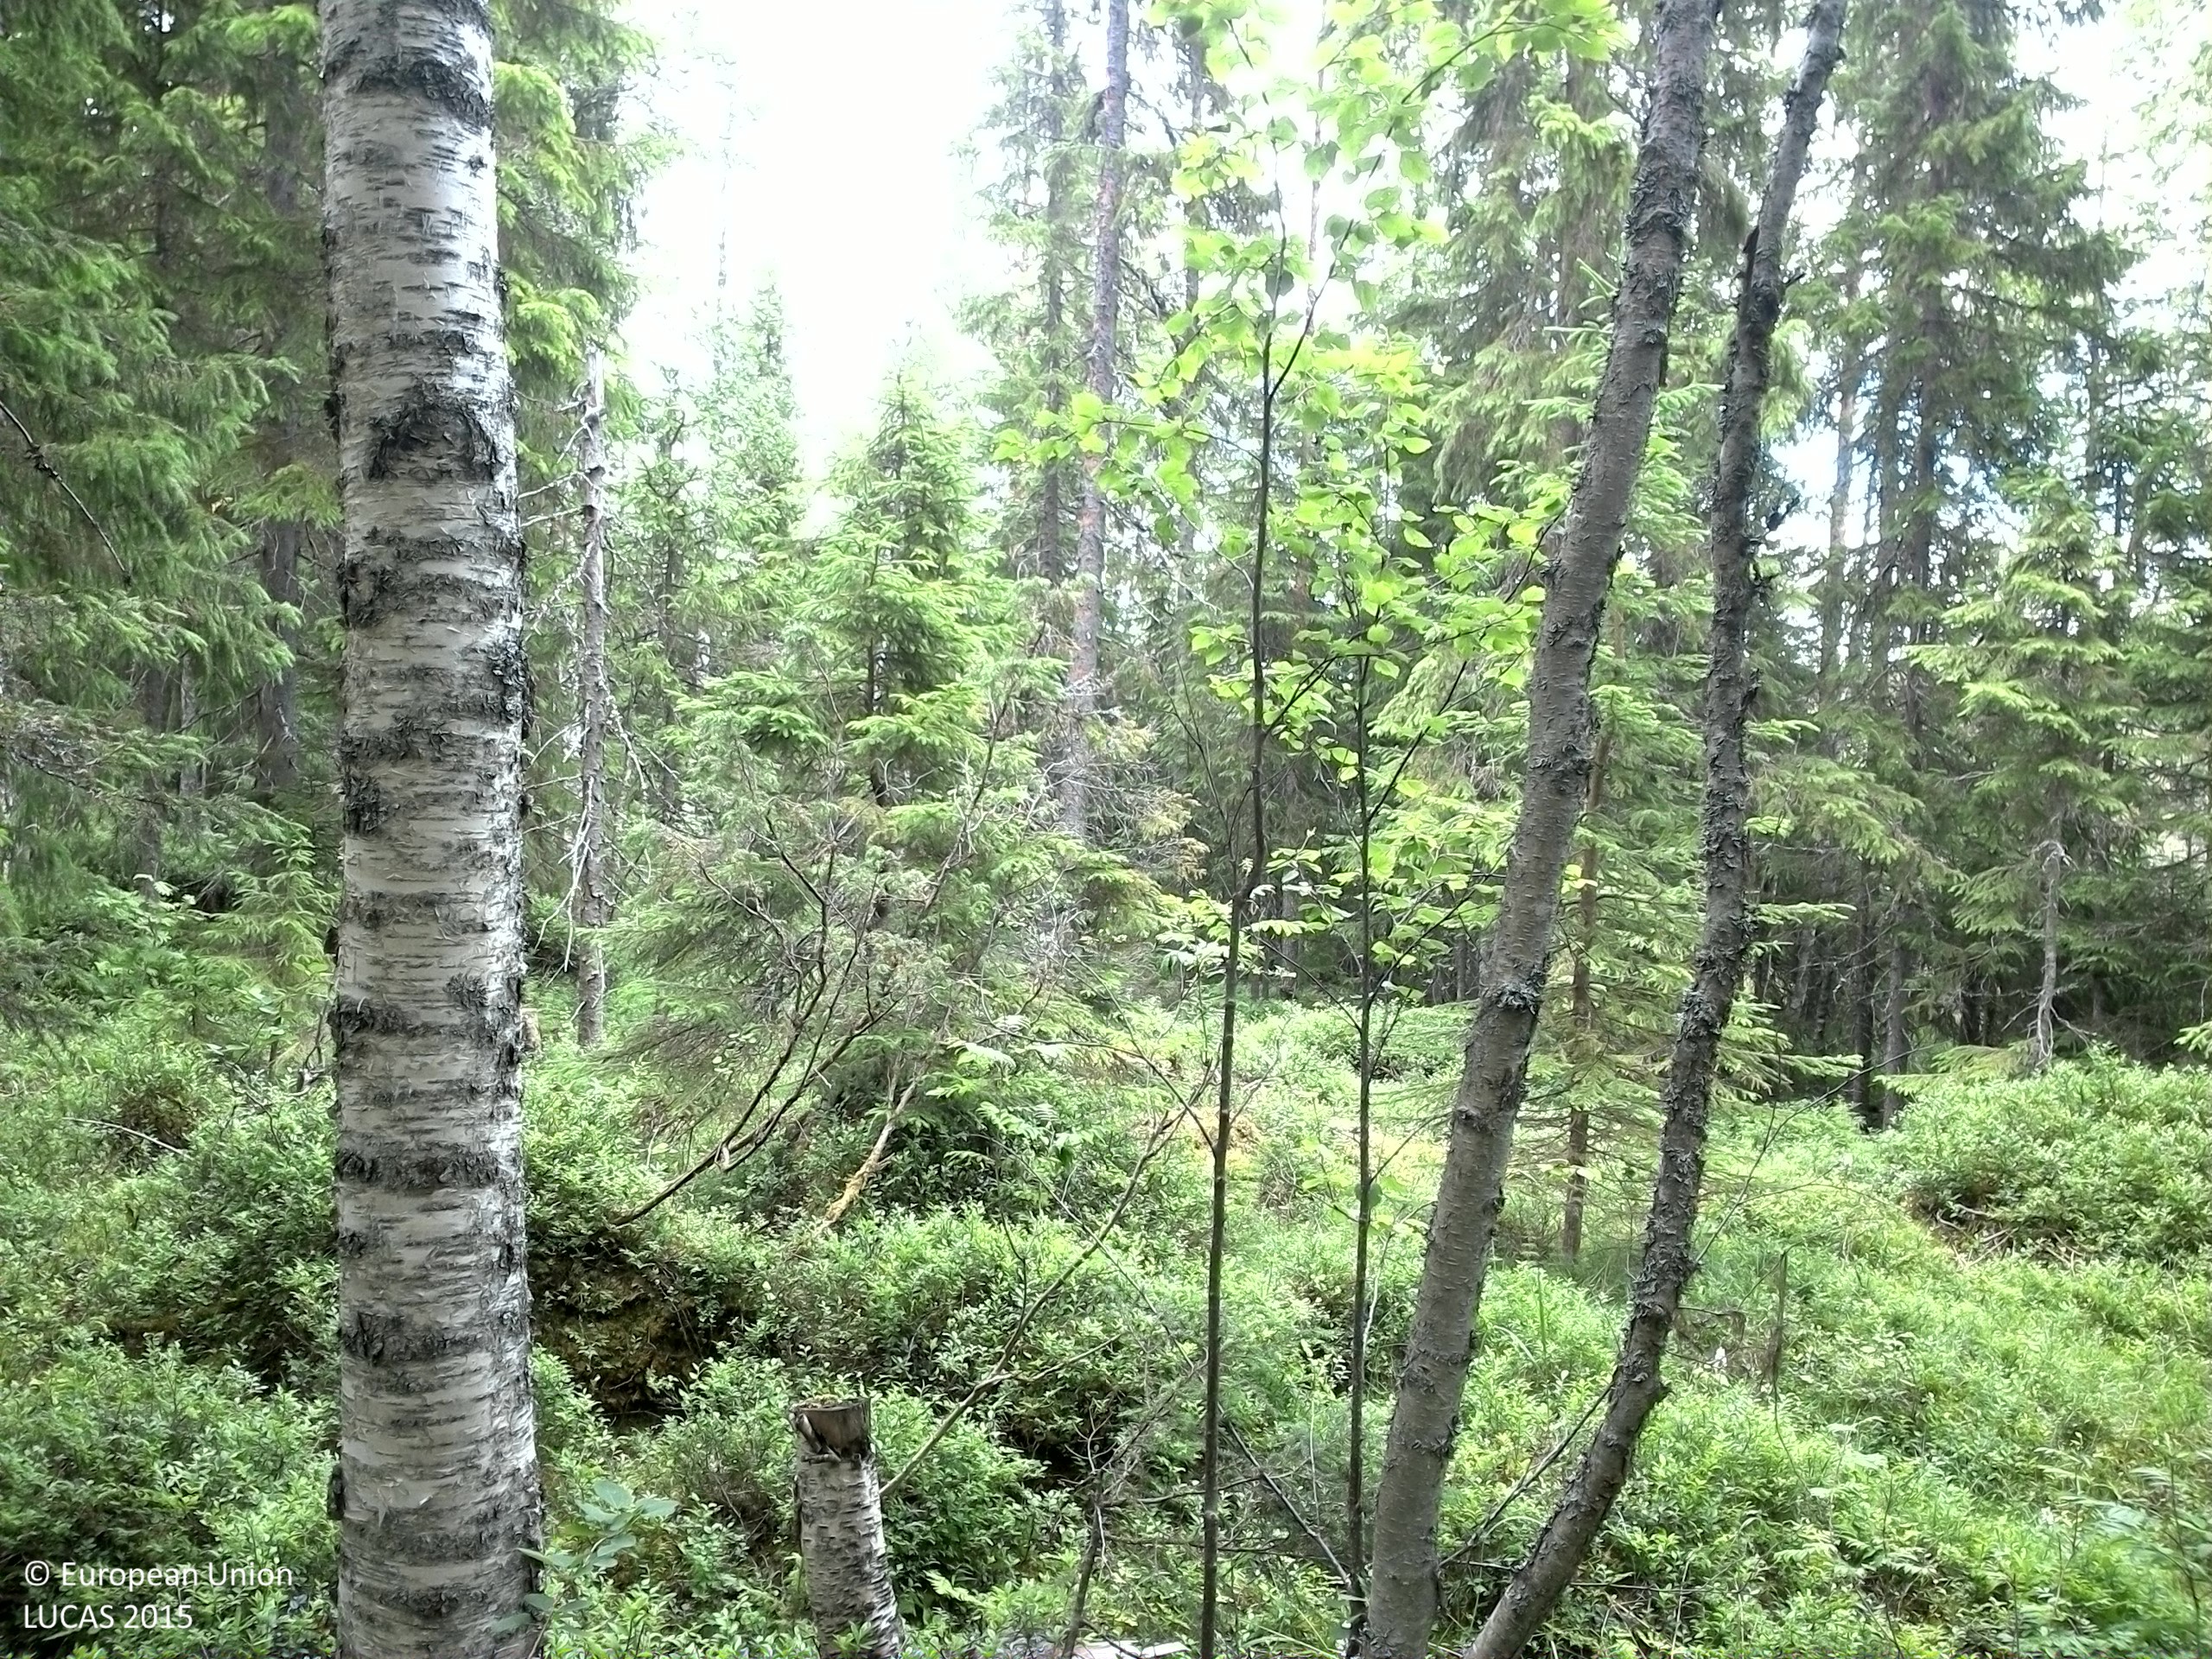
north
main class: Woodland
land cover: Spruce dominated mixed woodland
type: boreal forest
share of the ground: > 75 %
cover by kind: coniferous forest trees 60 %, broadleaved forest trees 20 %, shrubs 20 %
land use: Forestry
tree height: > 5 m
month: July
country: SE
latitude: 62.7622
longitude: 17.2833
